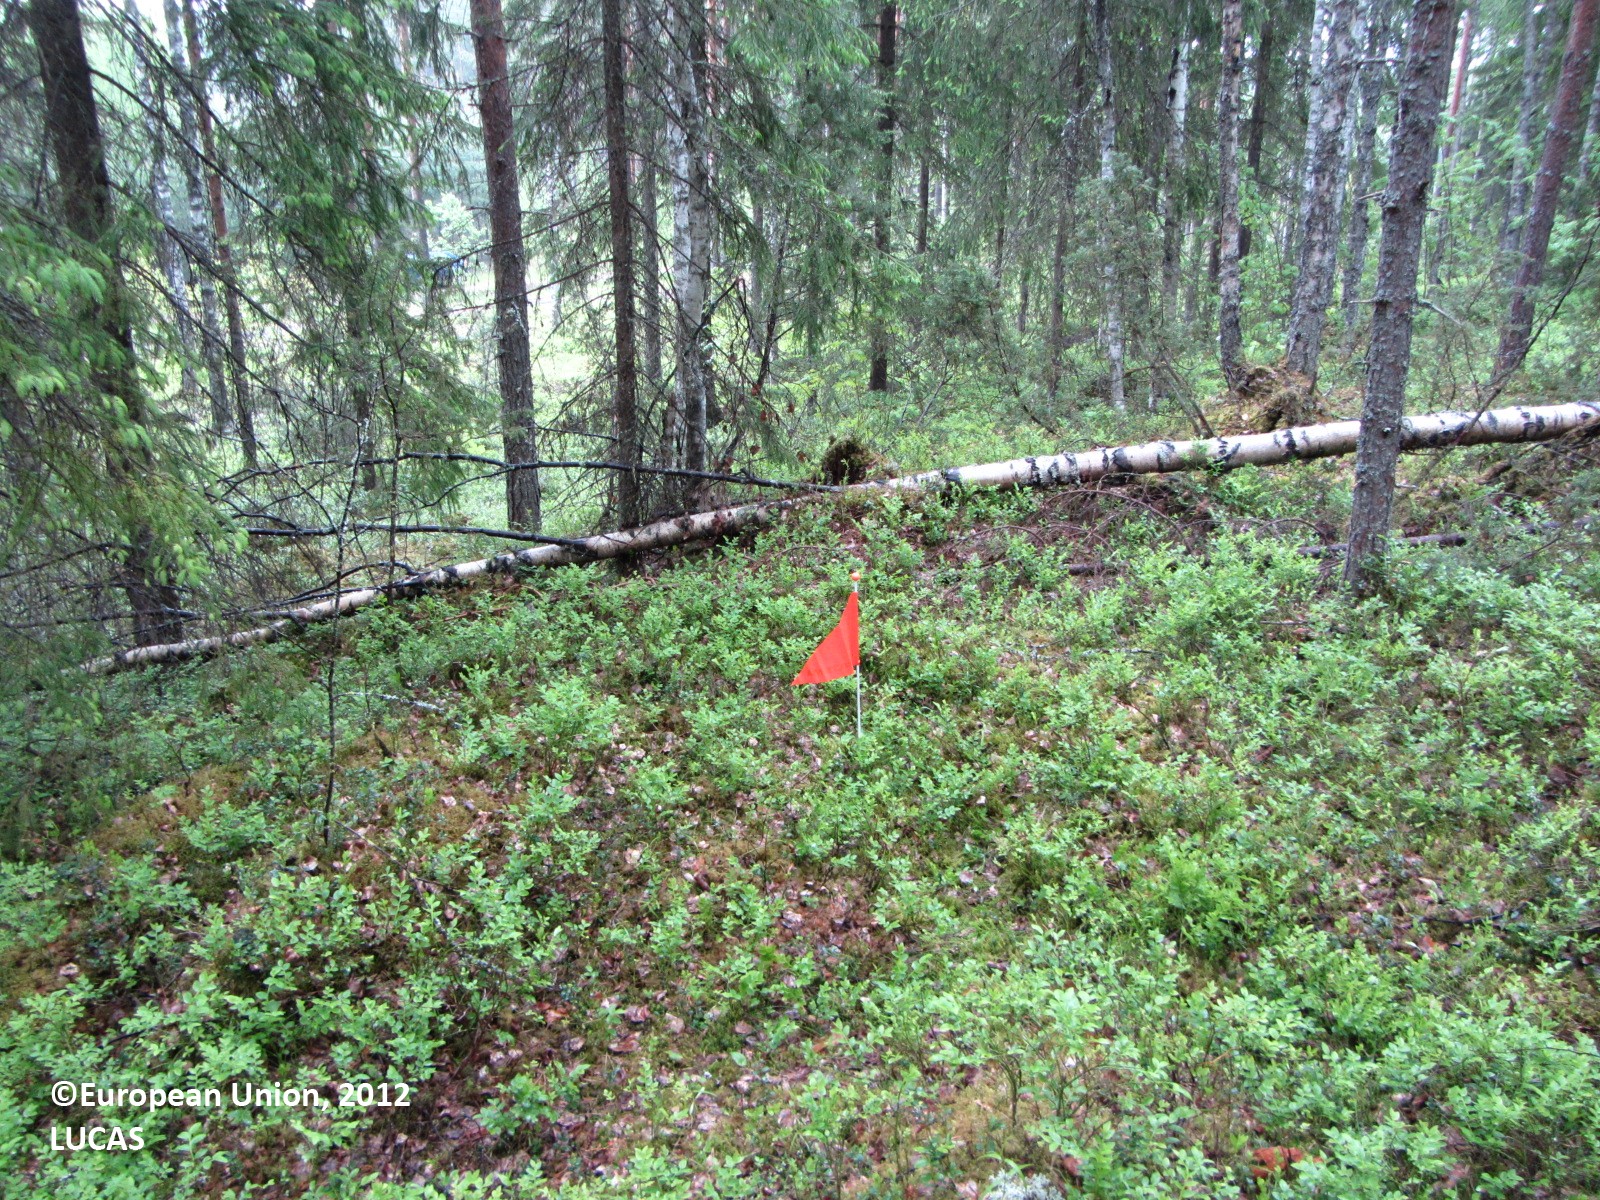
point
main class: Woodland
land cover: Spruce dominated mixed woodland
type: boreal forest
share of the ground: 50 - 75 %
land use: Forestry
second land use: Sport
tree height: > 5 m
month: June
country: FI
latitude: 61.8972
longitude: 25.1231
